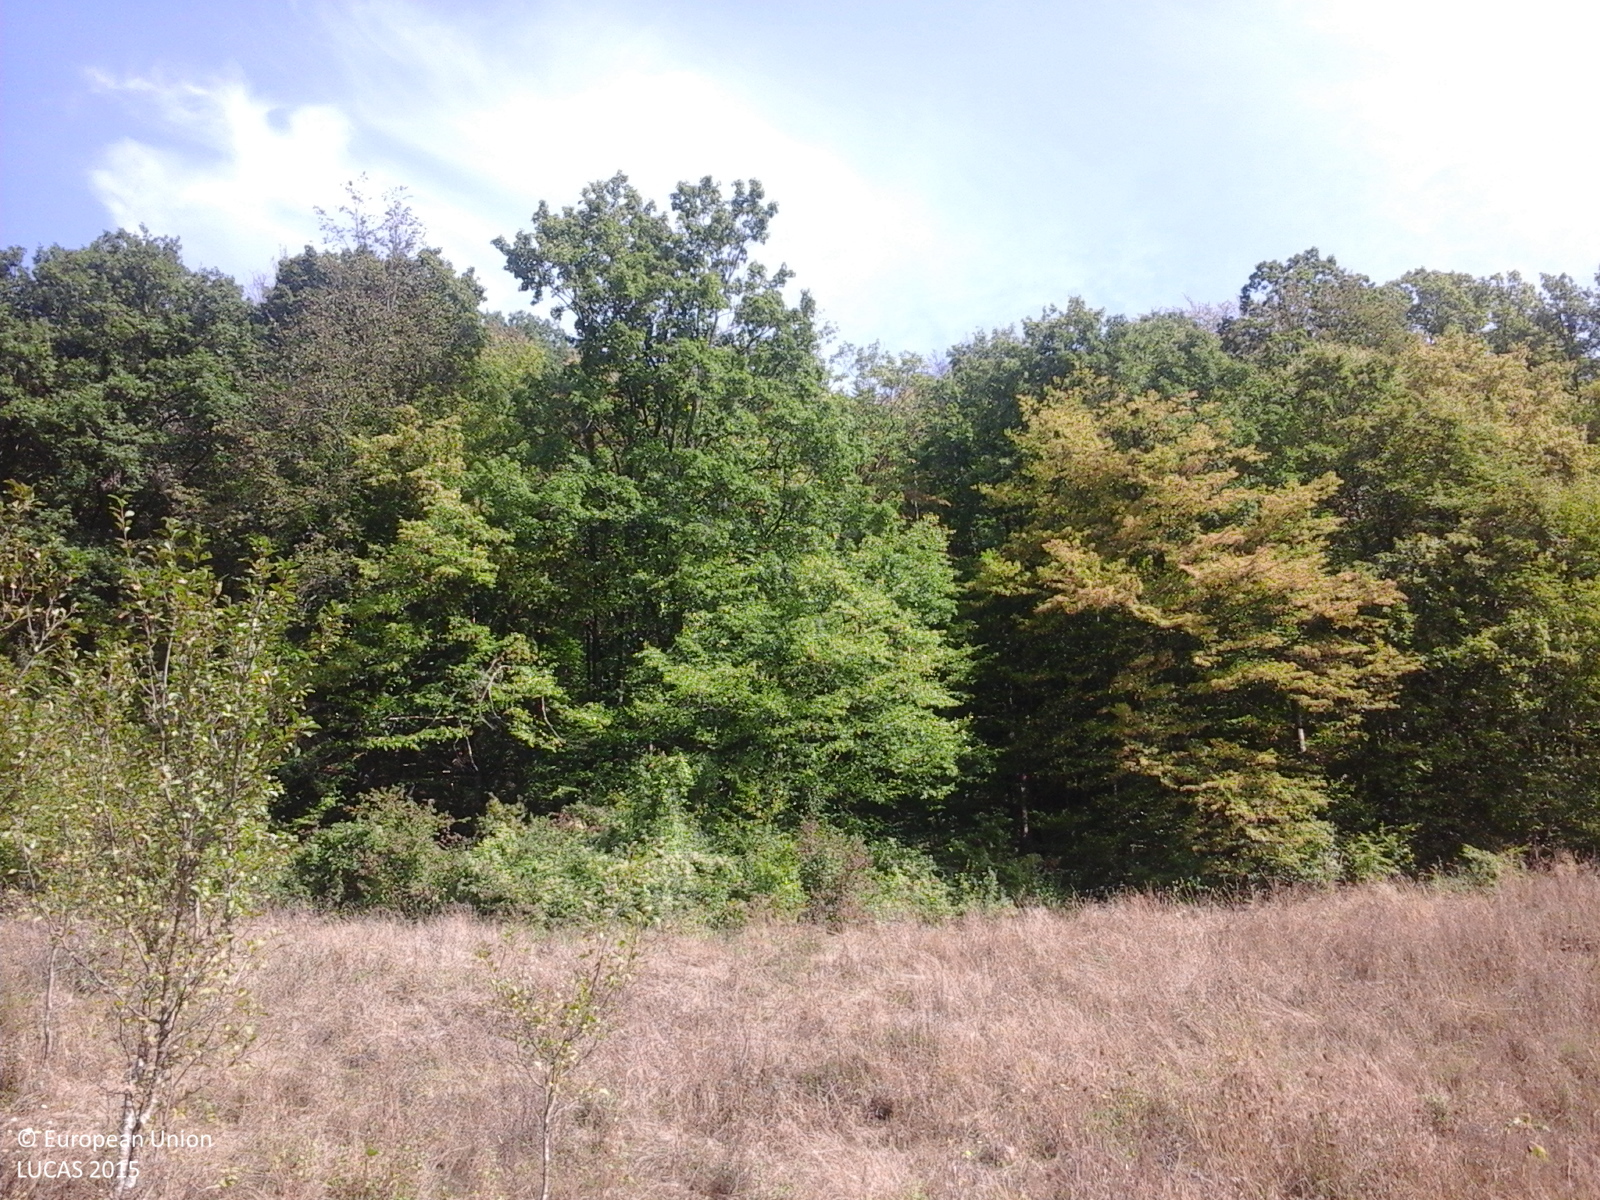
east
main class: Grassland
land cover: Spontaneously vegetated surfaces
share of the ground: > 75 %
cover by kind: herbaceous plants 100 %
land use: Fallow land
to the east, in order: Spontaneously vegetated surfaces; Other fruit trees and berries; Spontaneously vegetated surfaces; Broadleaved woodland
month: September
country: RO
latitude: 47.2394
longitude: 23.6686
